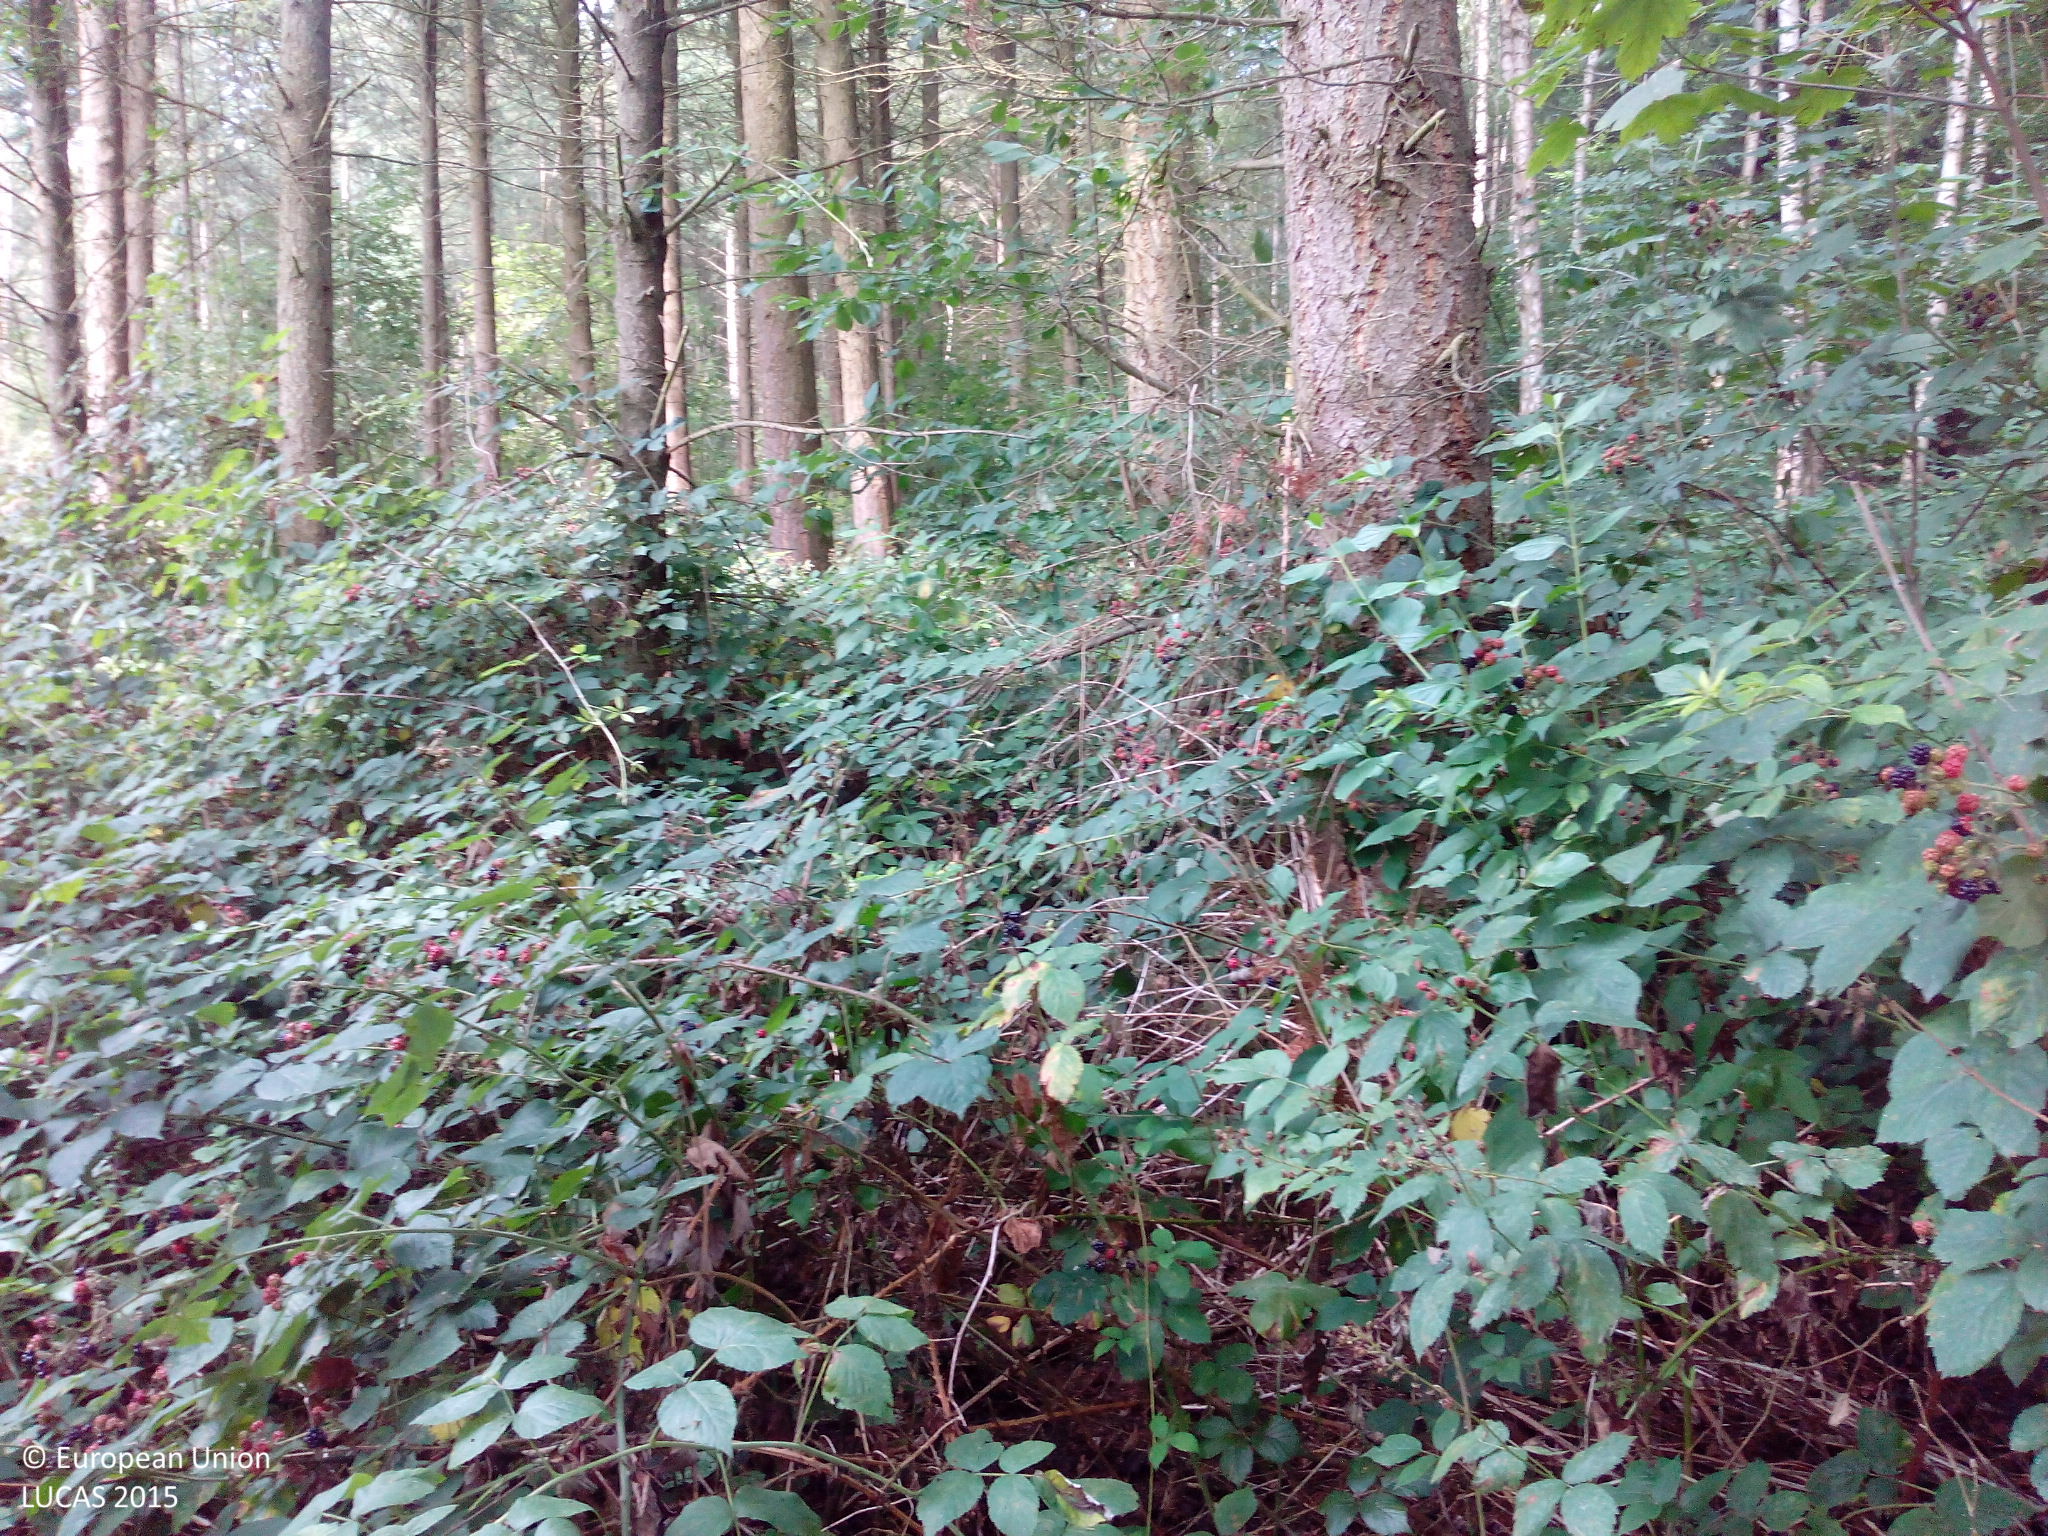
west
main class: Woodland
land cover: Spruce dominated coniferous woodland
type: hemiboreal forest and nemoral coniferous forest and mixed broadleaved-coniferous forest
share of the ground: 50 - 75 %
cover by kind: coniferous forest trees 65 %, shrubs 20 %, broadleaved forest trees 10 %, unconsolidated bare surface 5 %
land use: Forestry
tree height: > 5 m
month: August
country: DE
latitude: 50.3358
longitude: 7.4573
